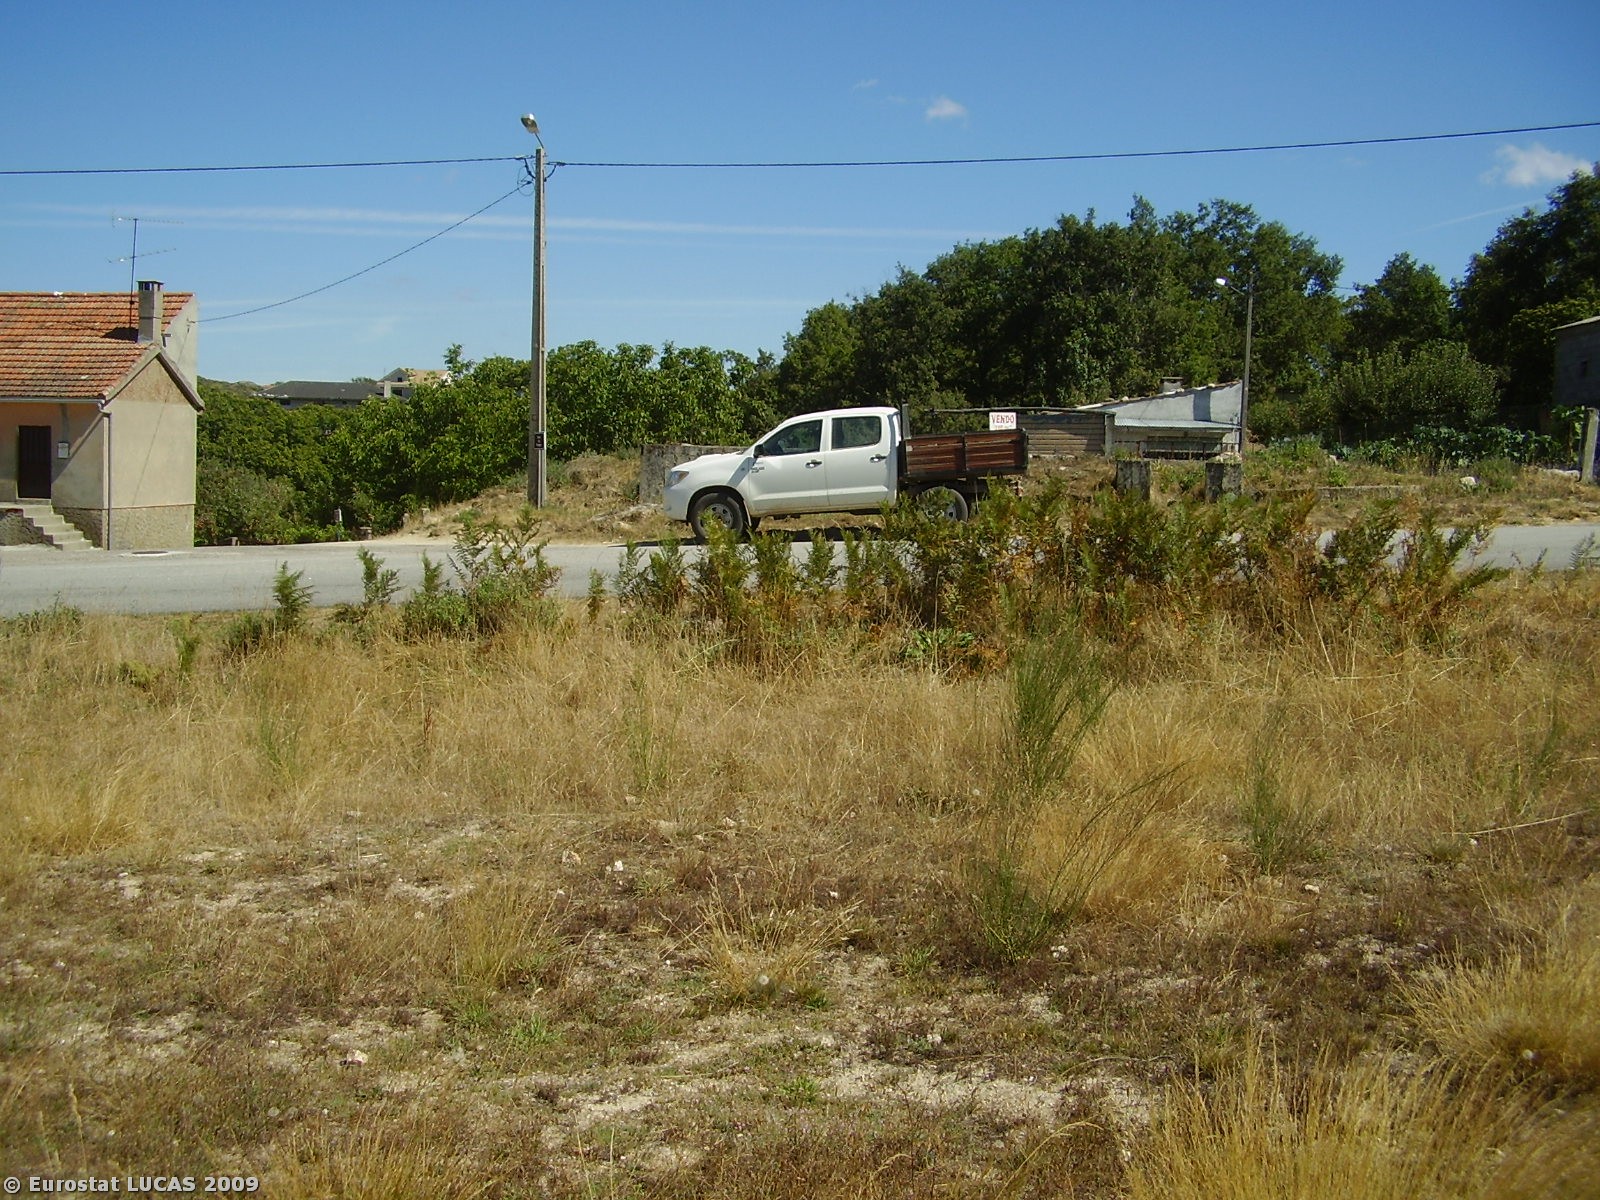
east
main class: Grassland
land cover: Spontaneously vegetated surfaces
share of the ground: > 75 %
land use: Fallow land
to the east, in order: Spontaneously vegetated surfaces; Paved roads, cycling and walking lanes; Electric lines; Paved roads, cycling and walking lanes; Electric lines; Paved roads, cycling and walking lanes; Dry stone walls; Vineyards; Apple fruit; Spontaneously vegetated surfaces; Dry stone walls; Other fruit trees and berries; Dry stone walls; Other fruit trees and berries; Dry stone walls; Spontaneously vegetated surfaces; Dry stone walls; Grassland without tree/shrub cover; Dry stone walls; Spontaneously vegetated surfaces; Shrubland without tree cover; Dry stone walls; Electric lines; Paved roads, cycling and walking lanes; Grass margins; Dry stone walls; Artificial constructions in urban areas
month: September
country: PT
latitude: 41.8481
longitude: -7.6364
